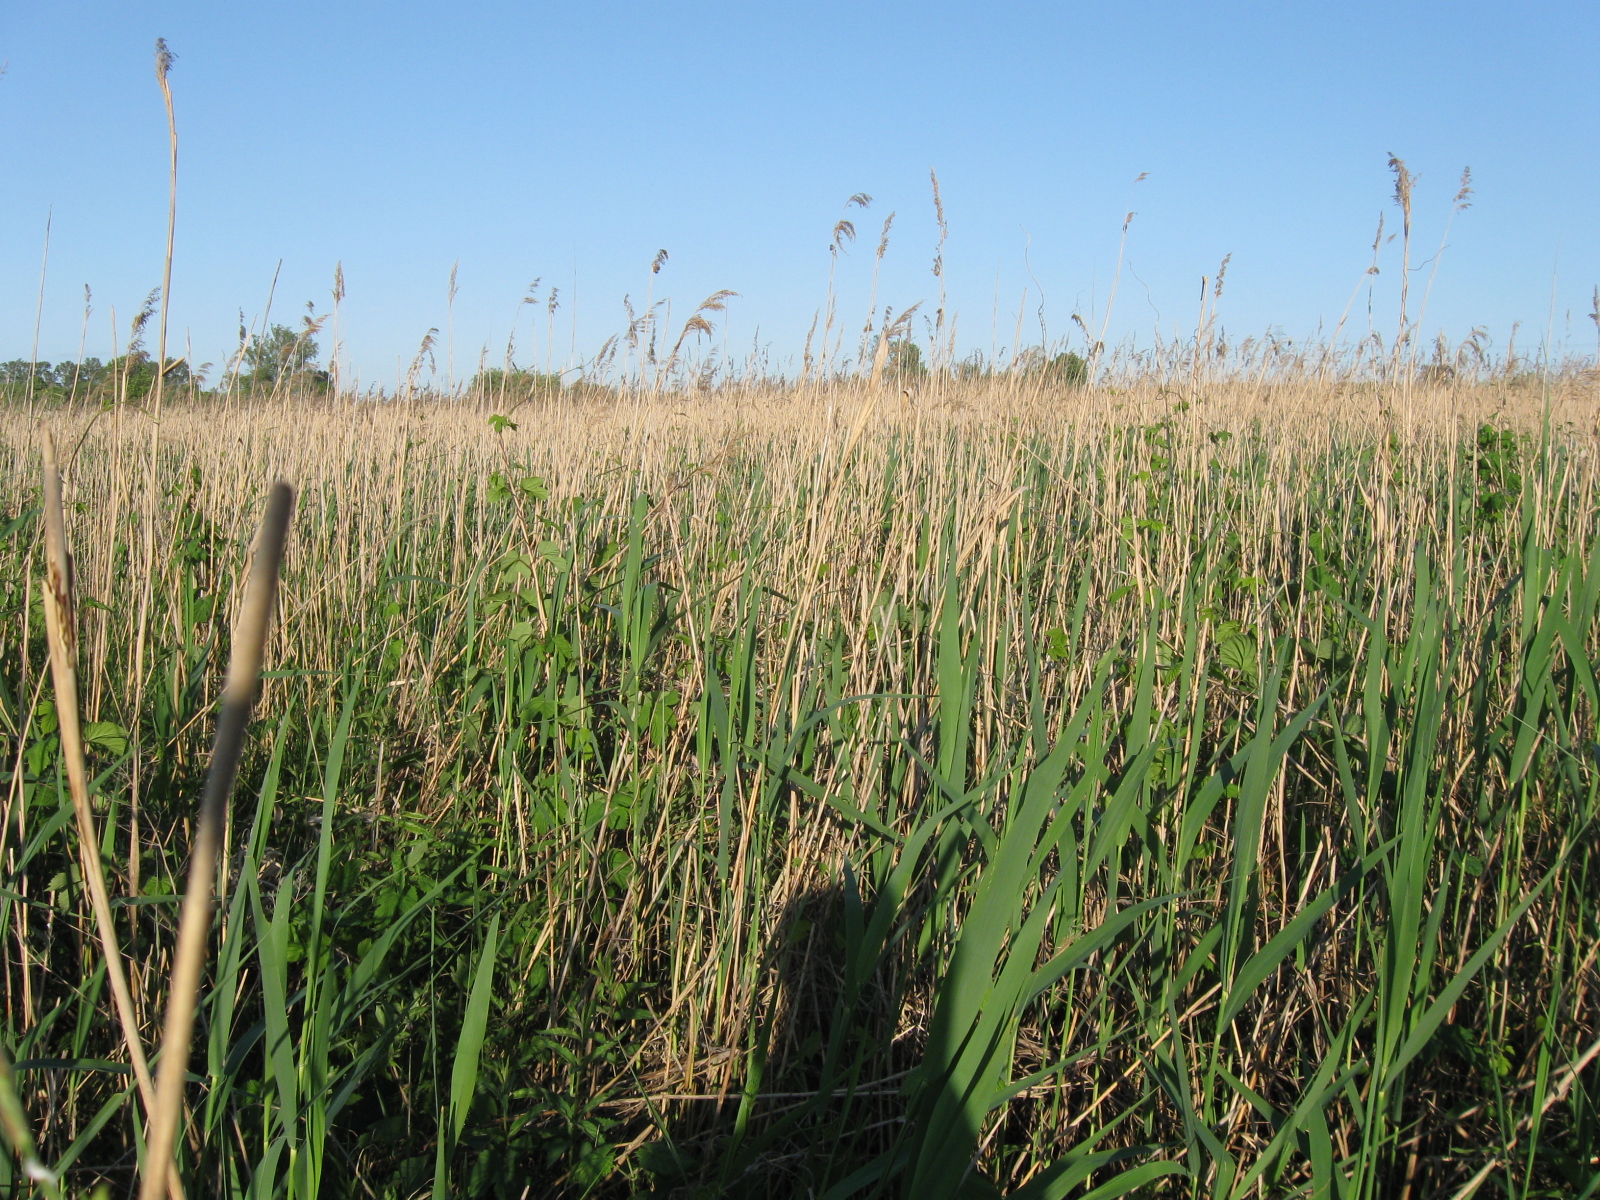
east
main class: Grassland
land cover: Spontaneously vegetated surfaces
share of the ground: > 75 %
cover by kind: herbaceous plants 100 %
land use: Semi-natural and natural areas not in use
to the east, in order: Spontaneously vegetated surfaces; Grassland without tree/shrub cover; Spontaneously vegetated surfaces; Grassland without tree/shrub cover; Spontaneously vegetated surfaces; Inland marshes
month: June
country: LT
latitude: 54.4265
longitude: 23.8536
